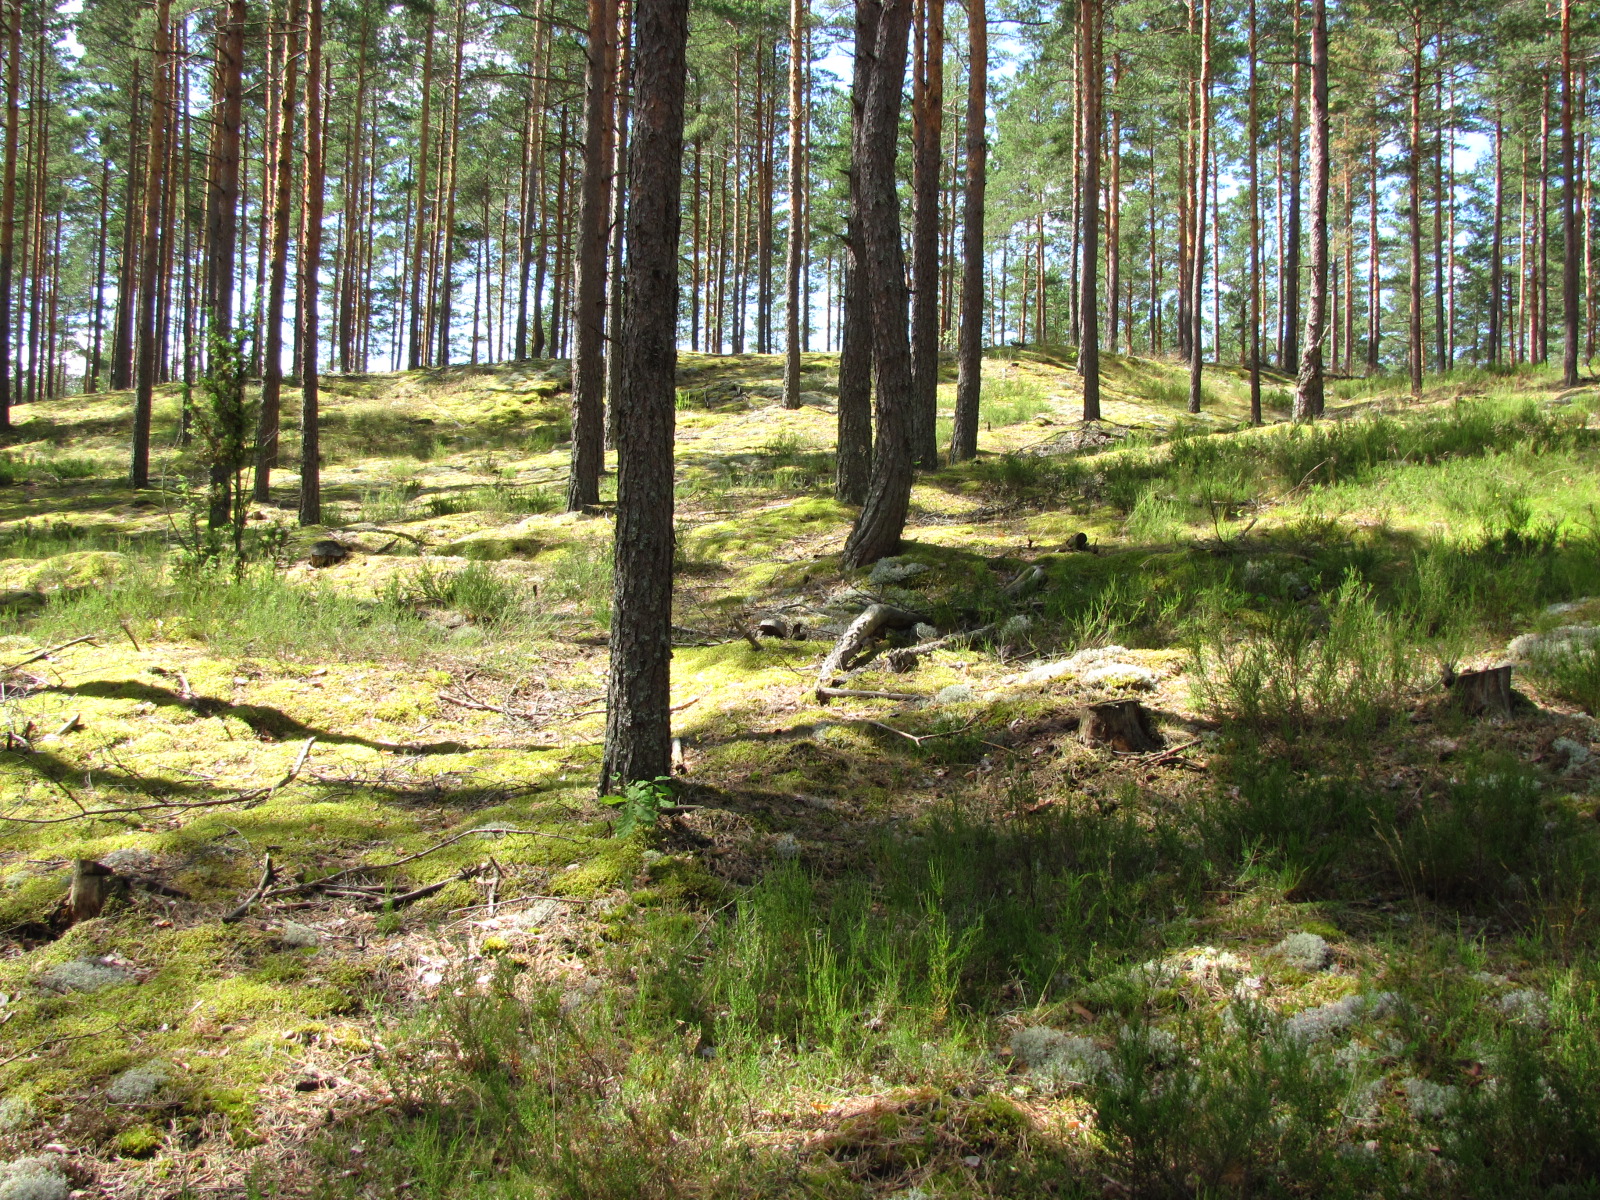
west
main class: Woodland
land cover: Pine dominated coniferous woodland
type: hemiboreal forest and nemoral coniferous forest and mixed broadleaved-coniferous forest
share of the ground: > 75 %
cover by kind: coniferous forest trees 80 %, lichens and mosses 15 %, shrubs 5 %
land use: Forestry
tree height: > 5 m
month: July
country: LV
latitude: 57.0201
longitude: 24.3715
